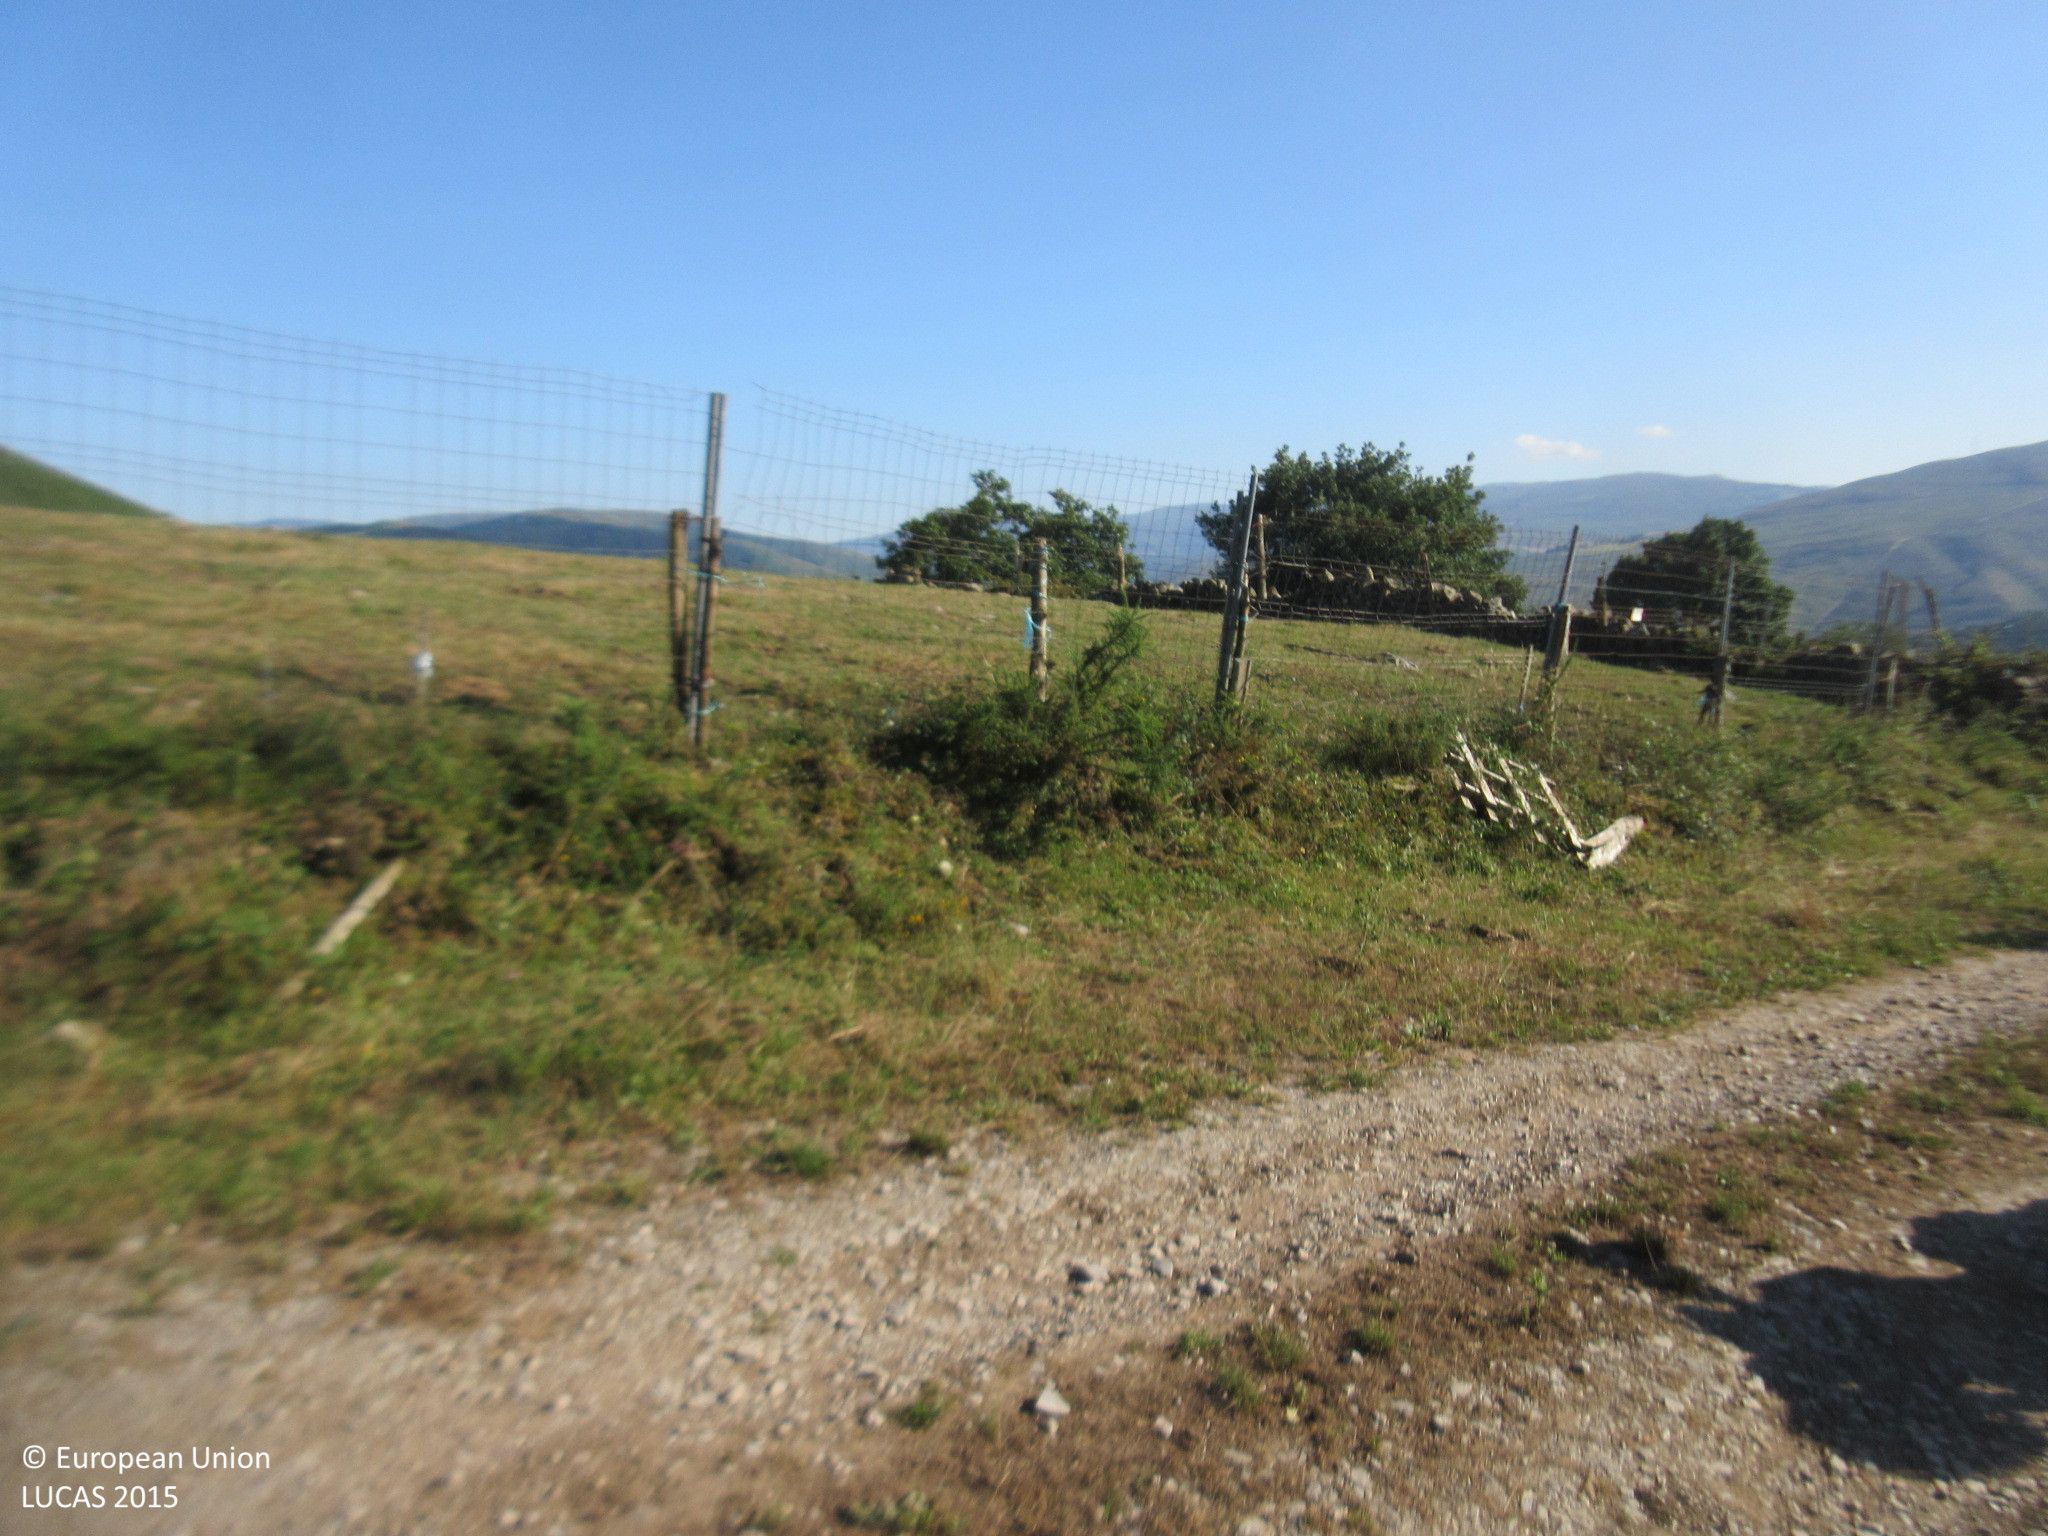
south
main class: Woodland
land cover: Pine dominated coniferous woodland
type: hemiboreal forest and nemoral coniferous forest and mixed broadleaved-coniferous forest
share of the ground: > 75 %
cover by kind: coniferous forest trees 100 %
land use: Forestry
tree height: > 5 m
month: July
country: ES
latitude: 43.1916
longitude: -3.8911
